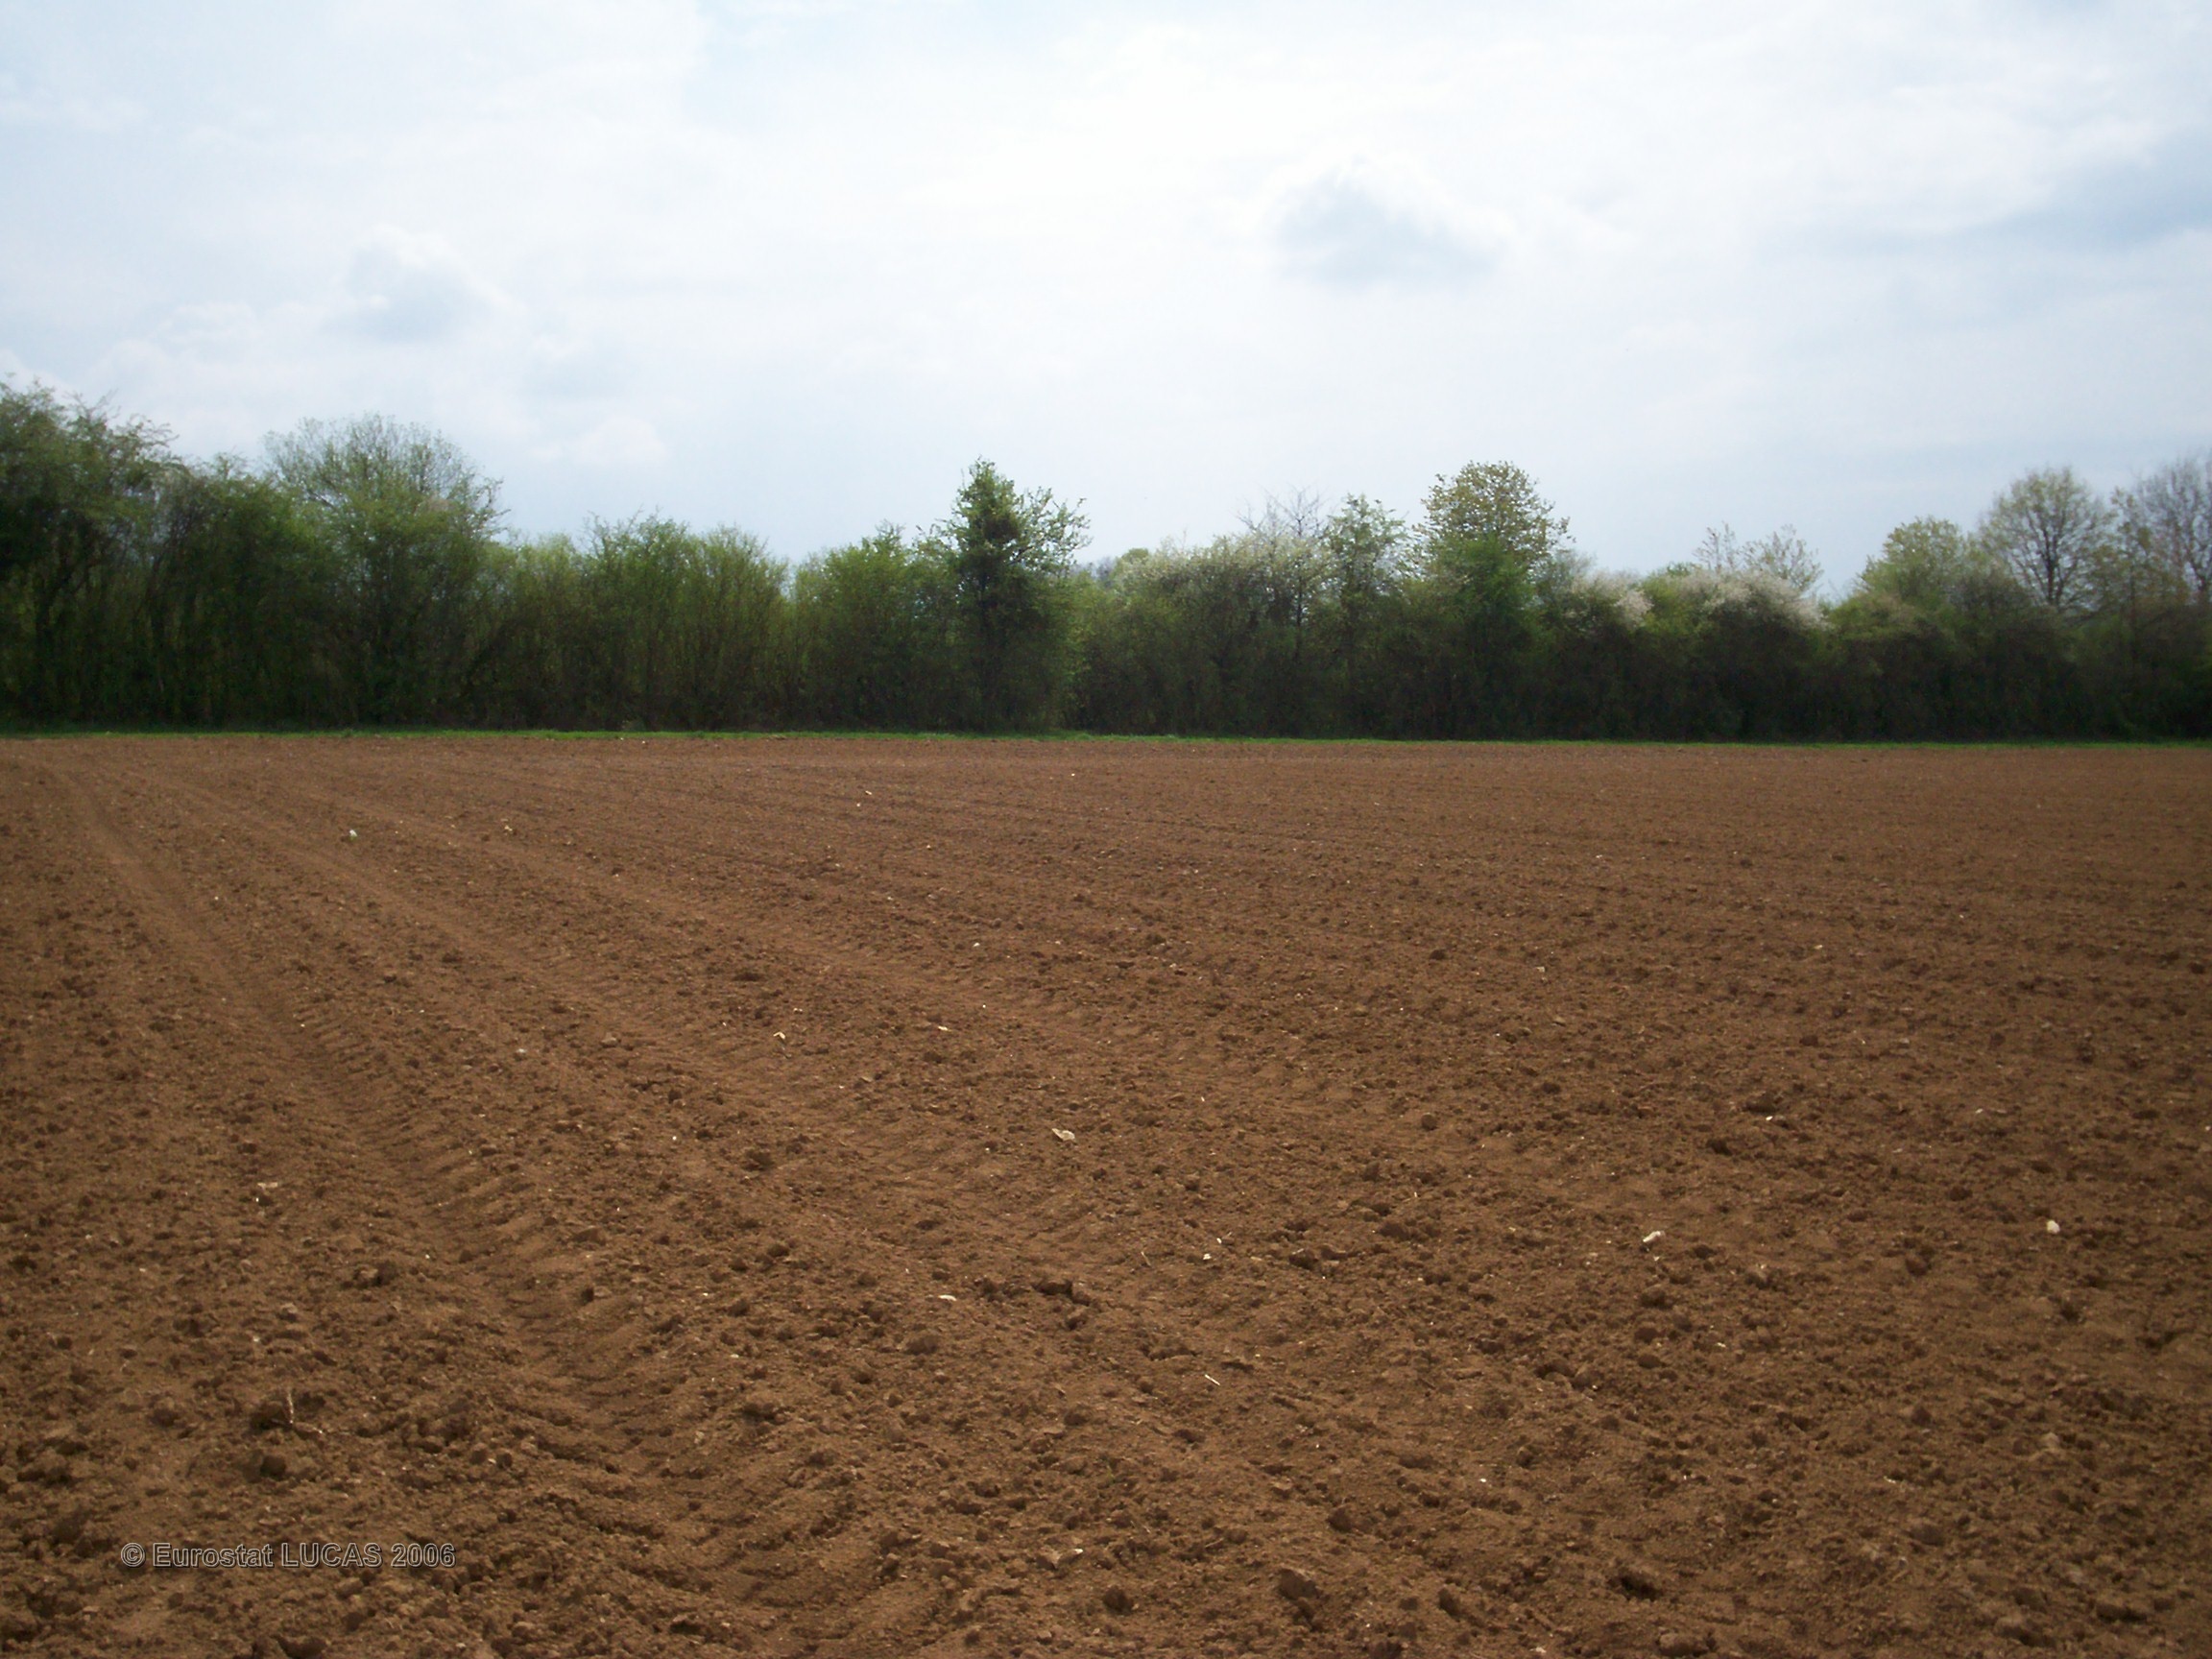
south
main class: Cropland
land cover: Maize
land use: Agriculture (excluding fallow land and kitchen gardens)
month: June
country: FR
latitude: 47.5744
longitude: 5.9997
